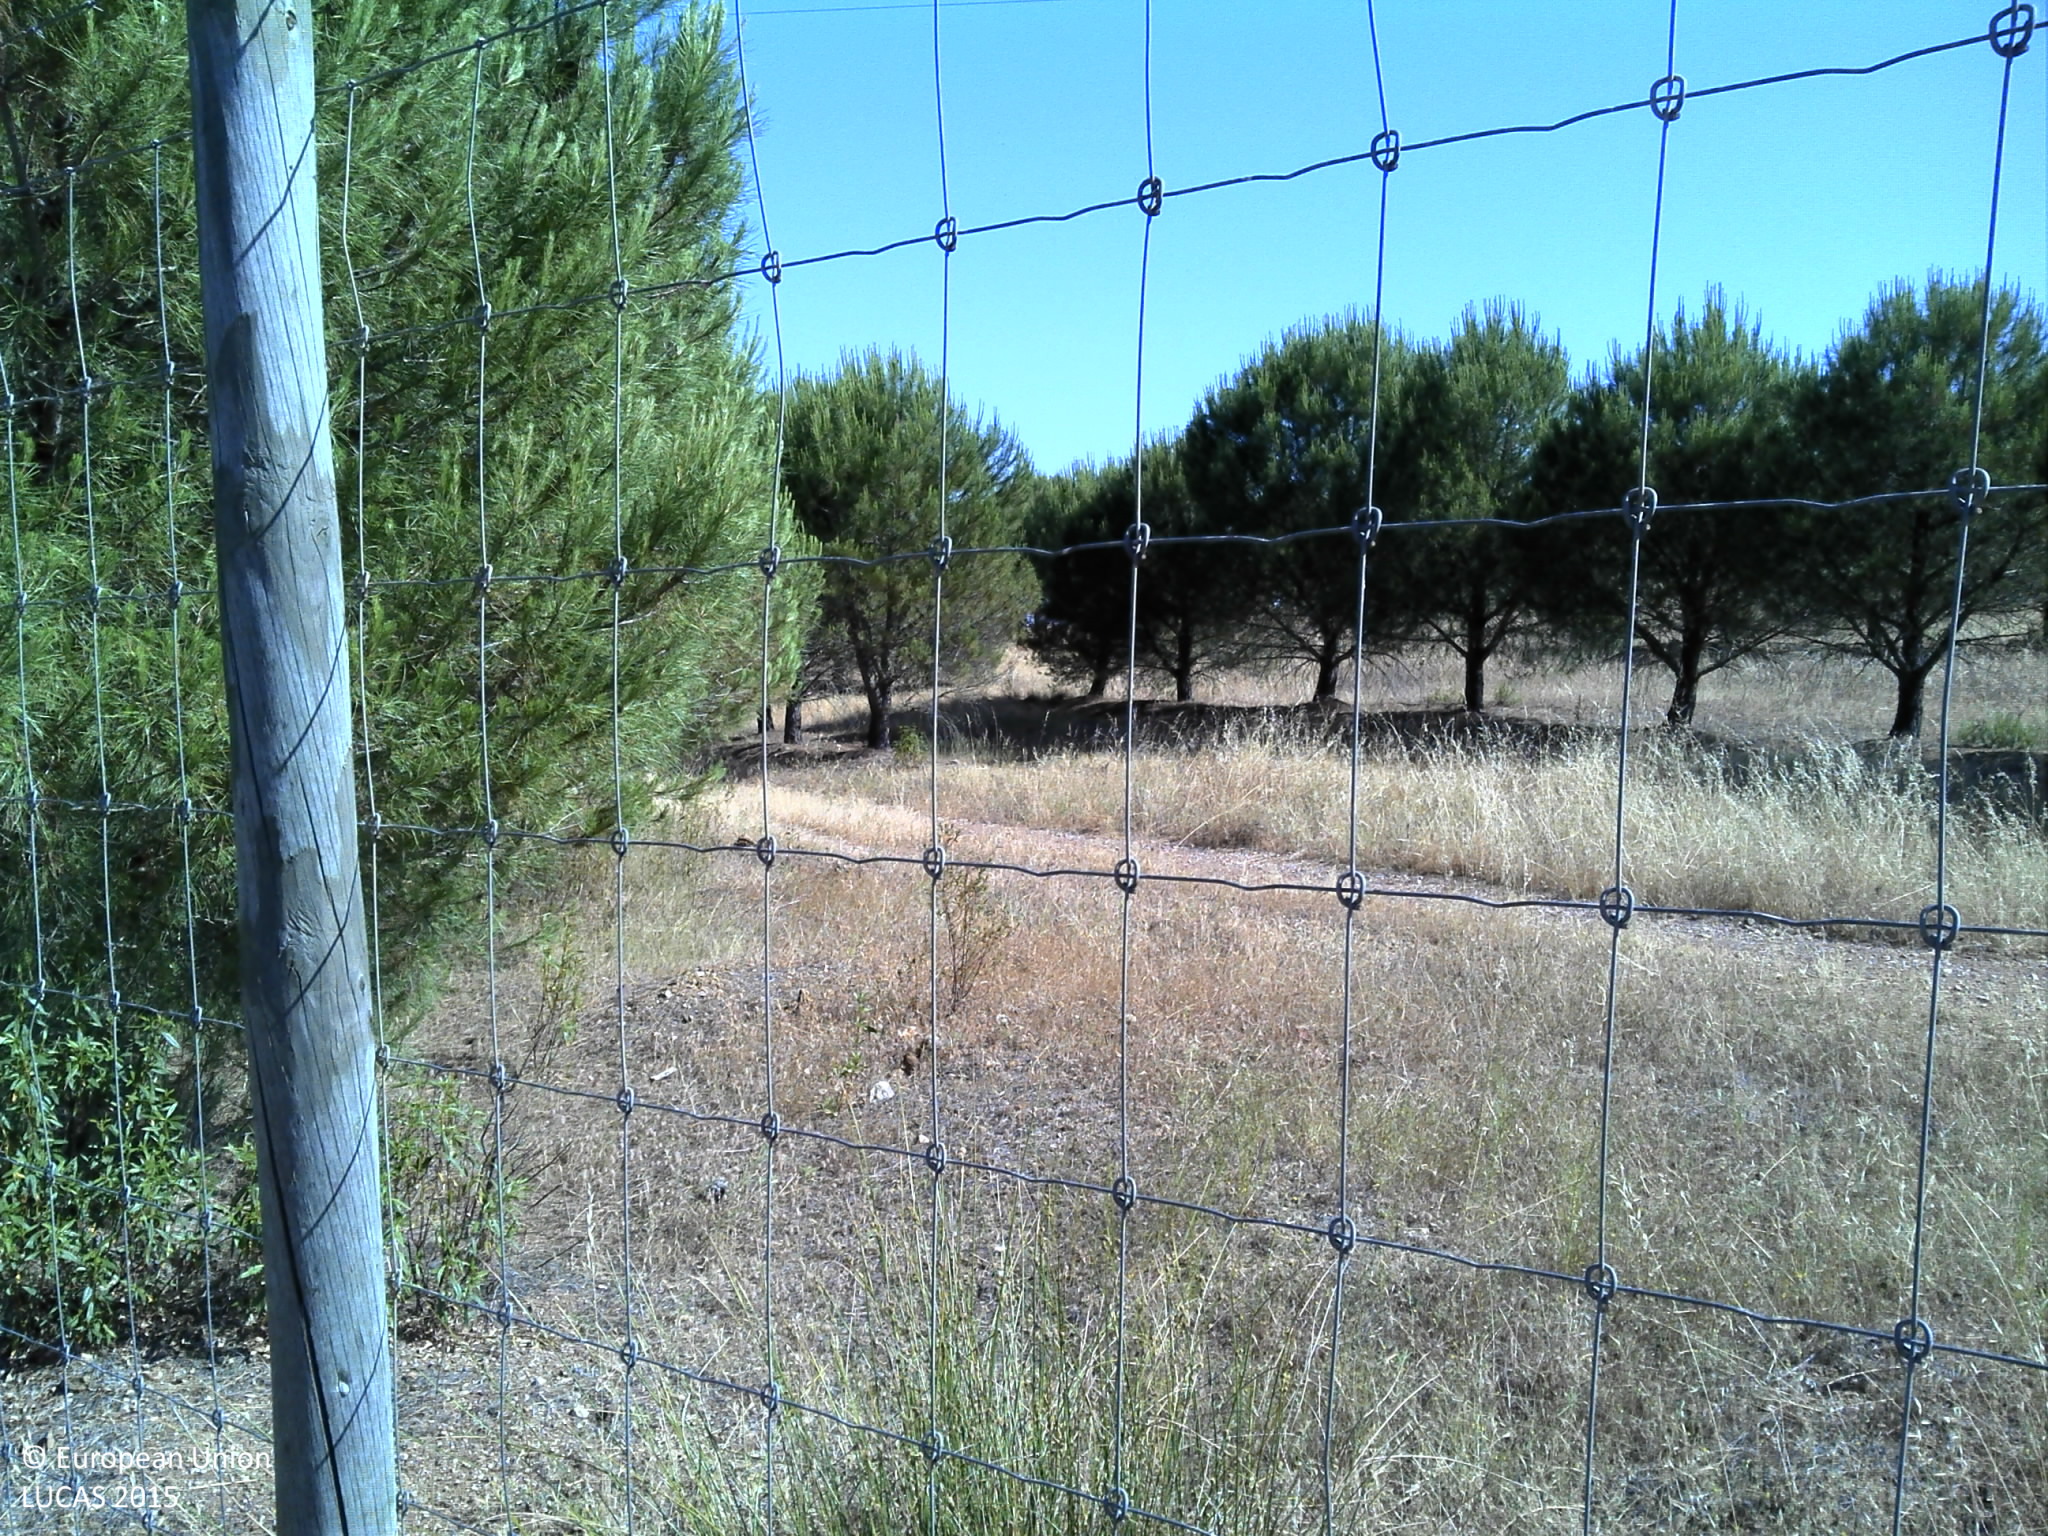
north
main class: Woodland
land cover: Pine dominated coniferous woodland
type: coniferous forest of the mediterranean region
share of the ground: 25 - 50 %
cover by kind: coniferous forest trees 75 %, herbaceous plants 25 %
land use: Forestry
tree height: < 5 m
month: June
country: PT
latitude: 37.6823
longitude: -7.6022
